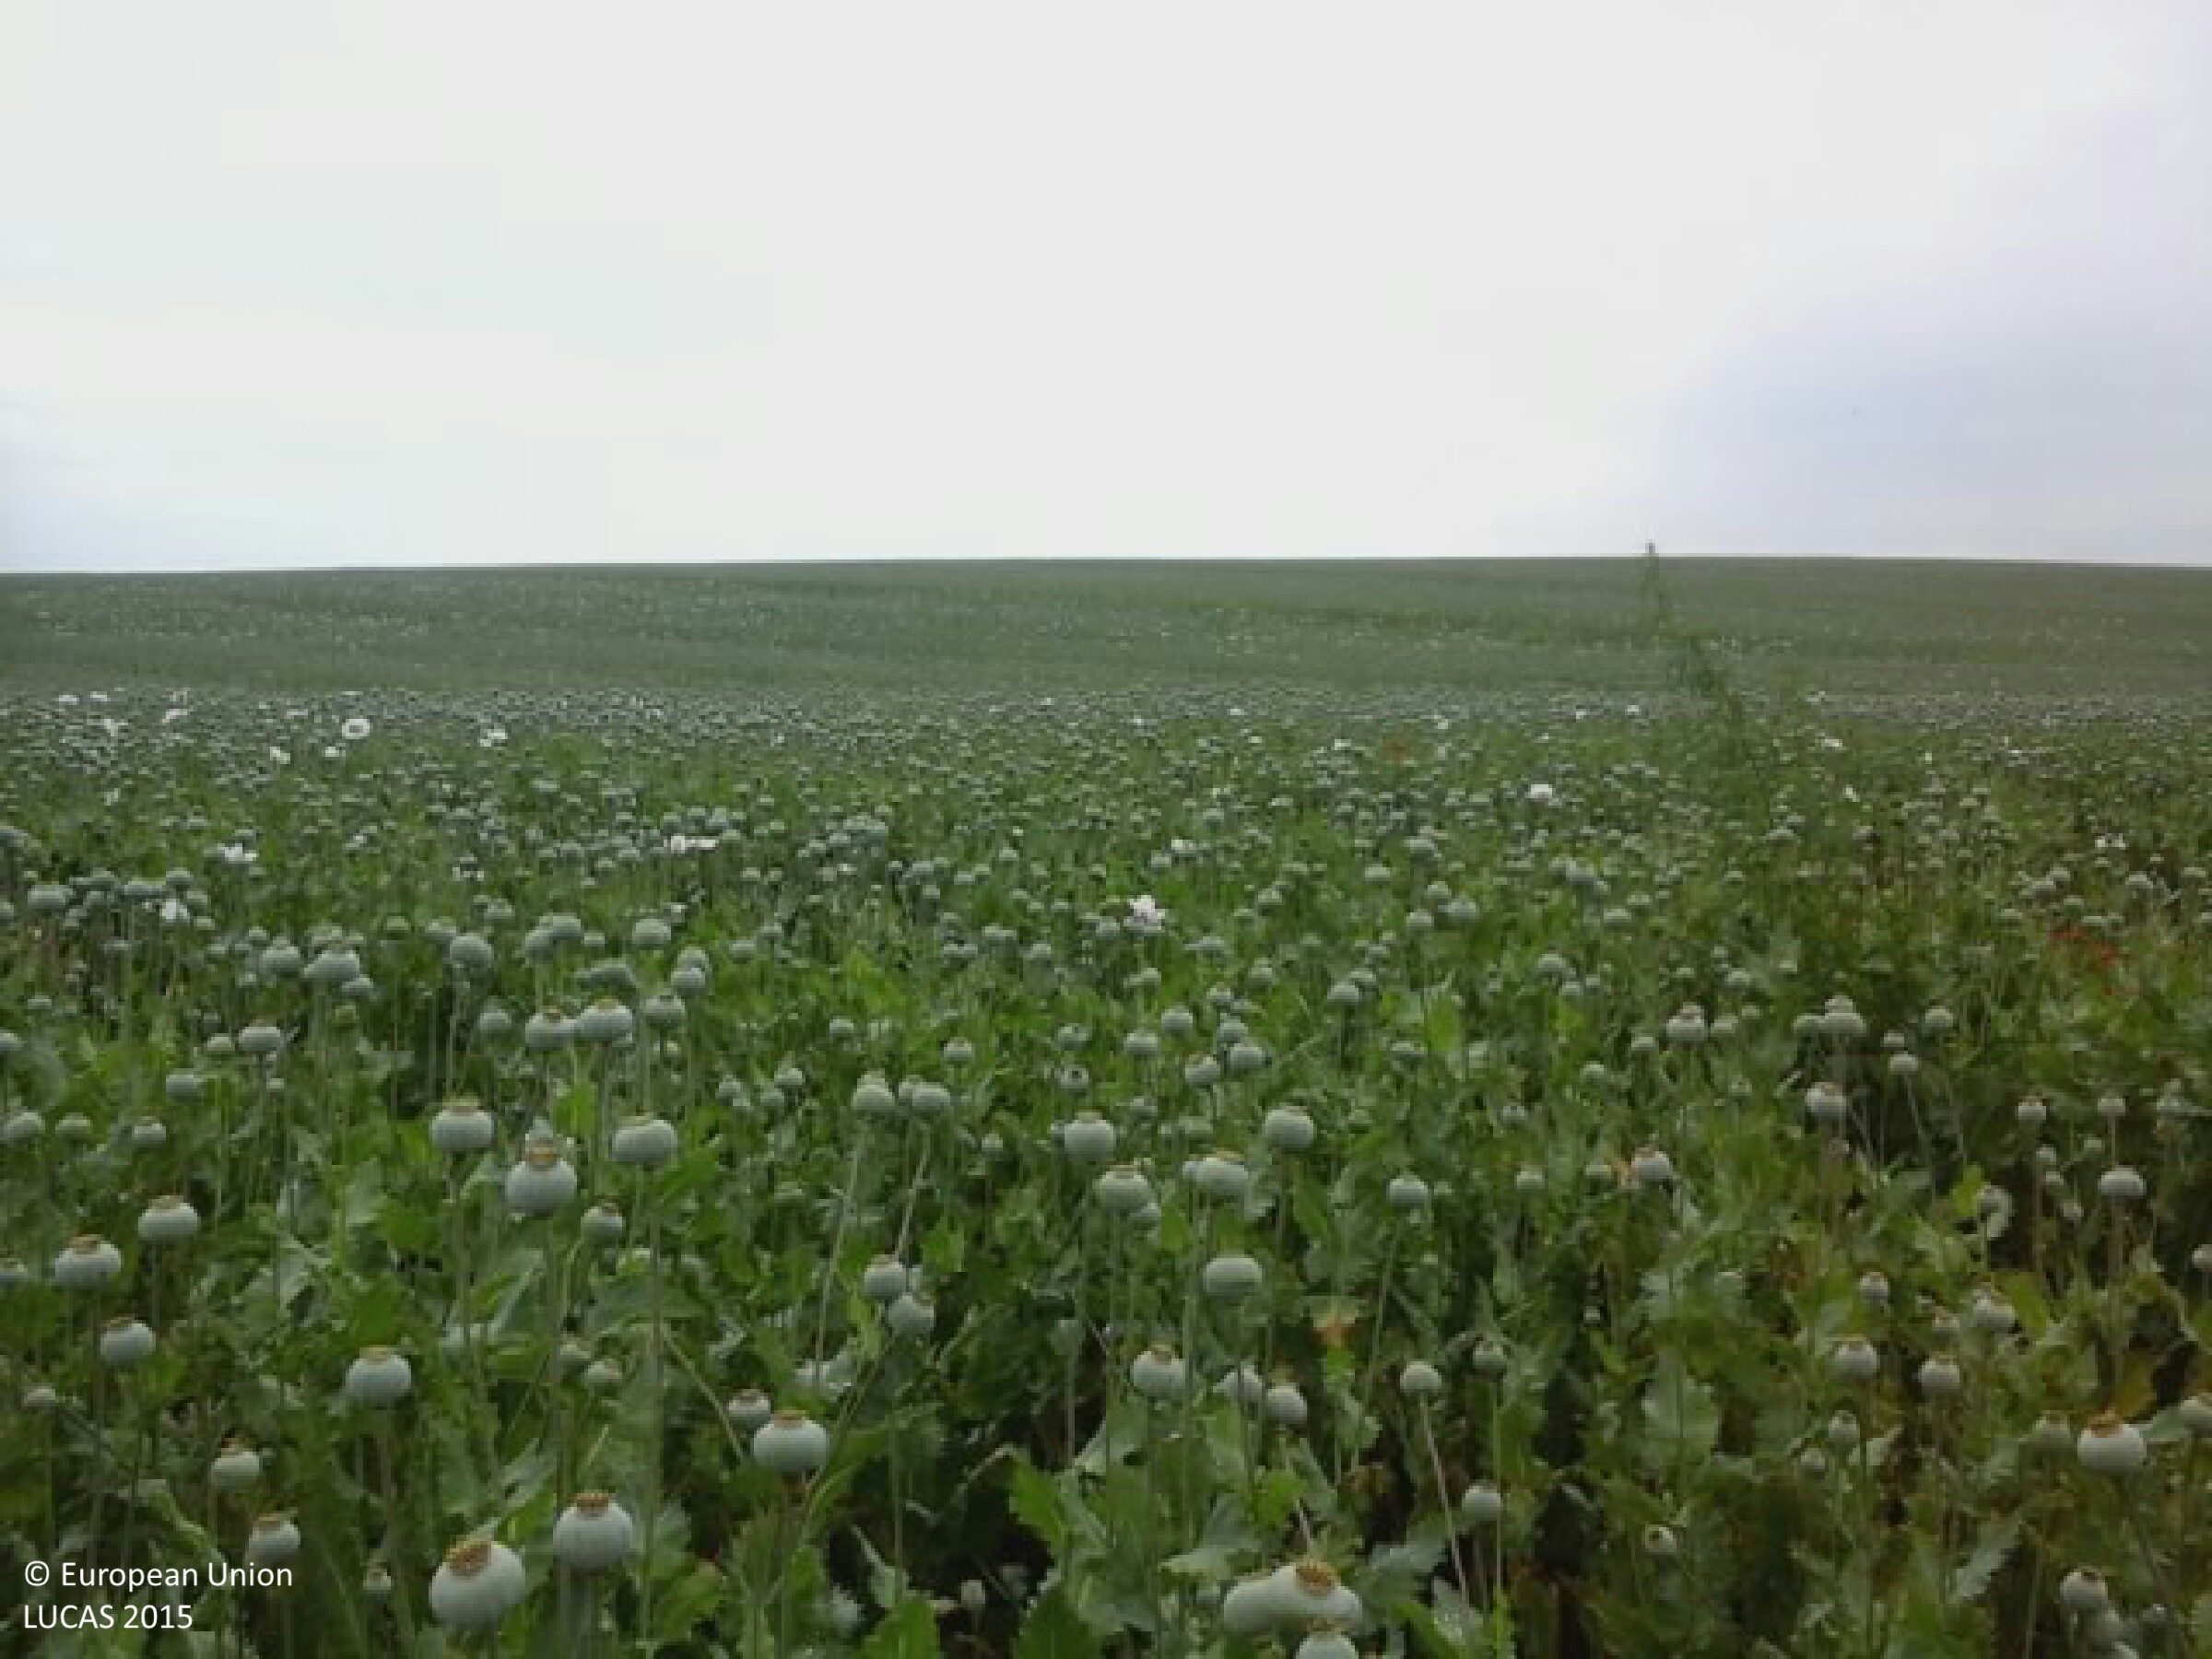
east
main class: Cropland
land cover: Other fibre and oleaginous crops
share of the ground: > 75 %
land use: Agriculture (excluding fallow land and kitchen gardens)
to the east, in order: Other fibre and oleaginous crops
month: June
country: HU
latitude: 46.2141
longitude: 19.1260
